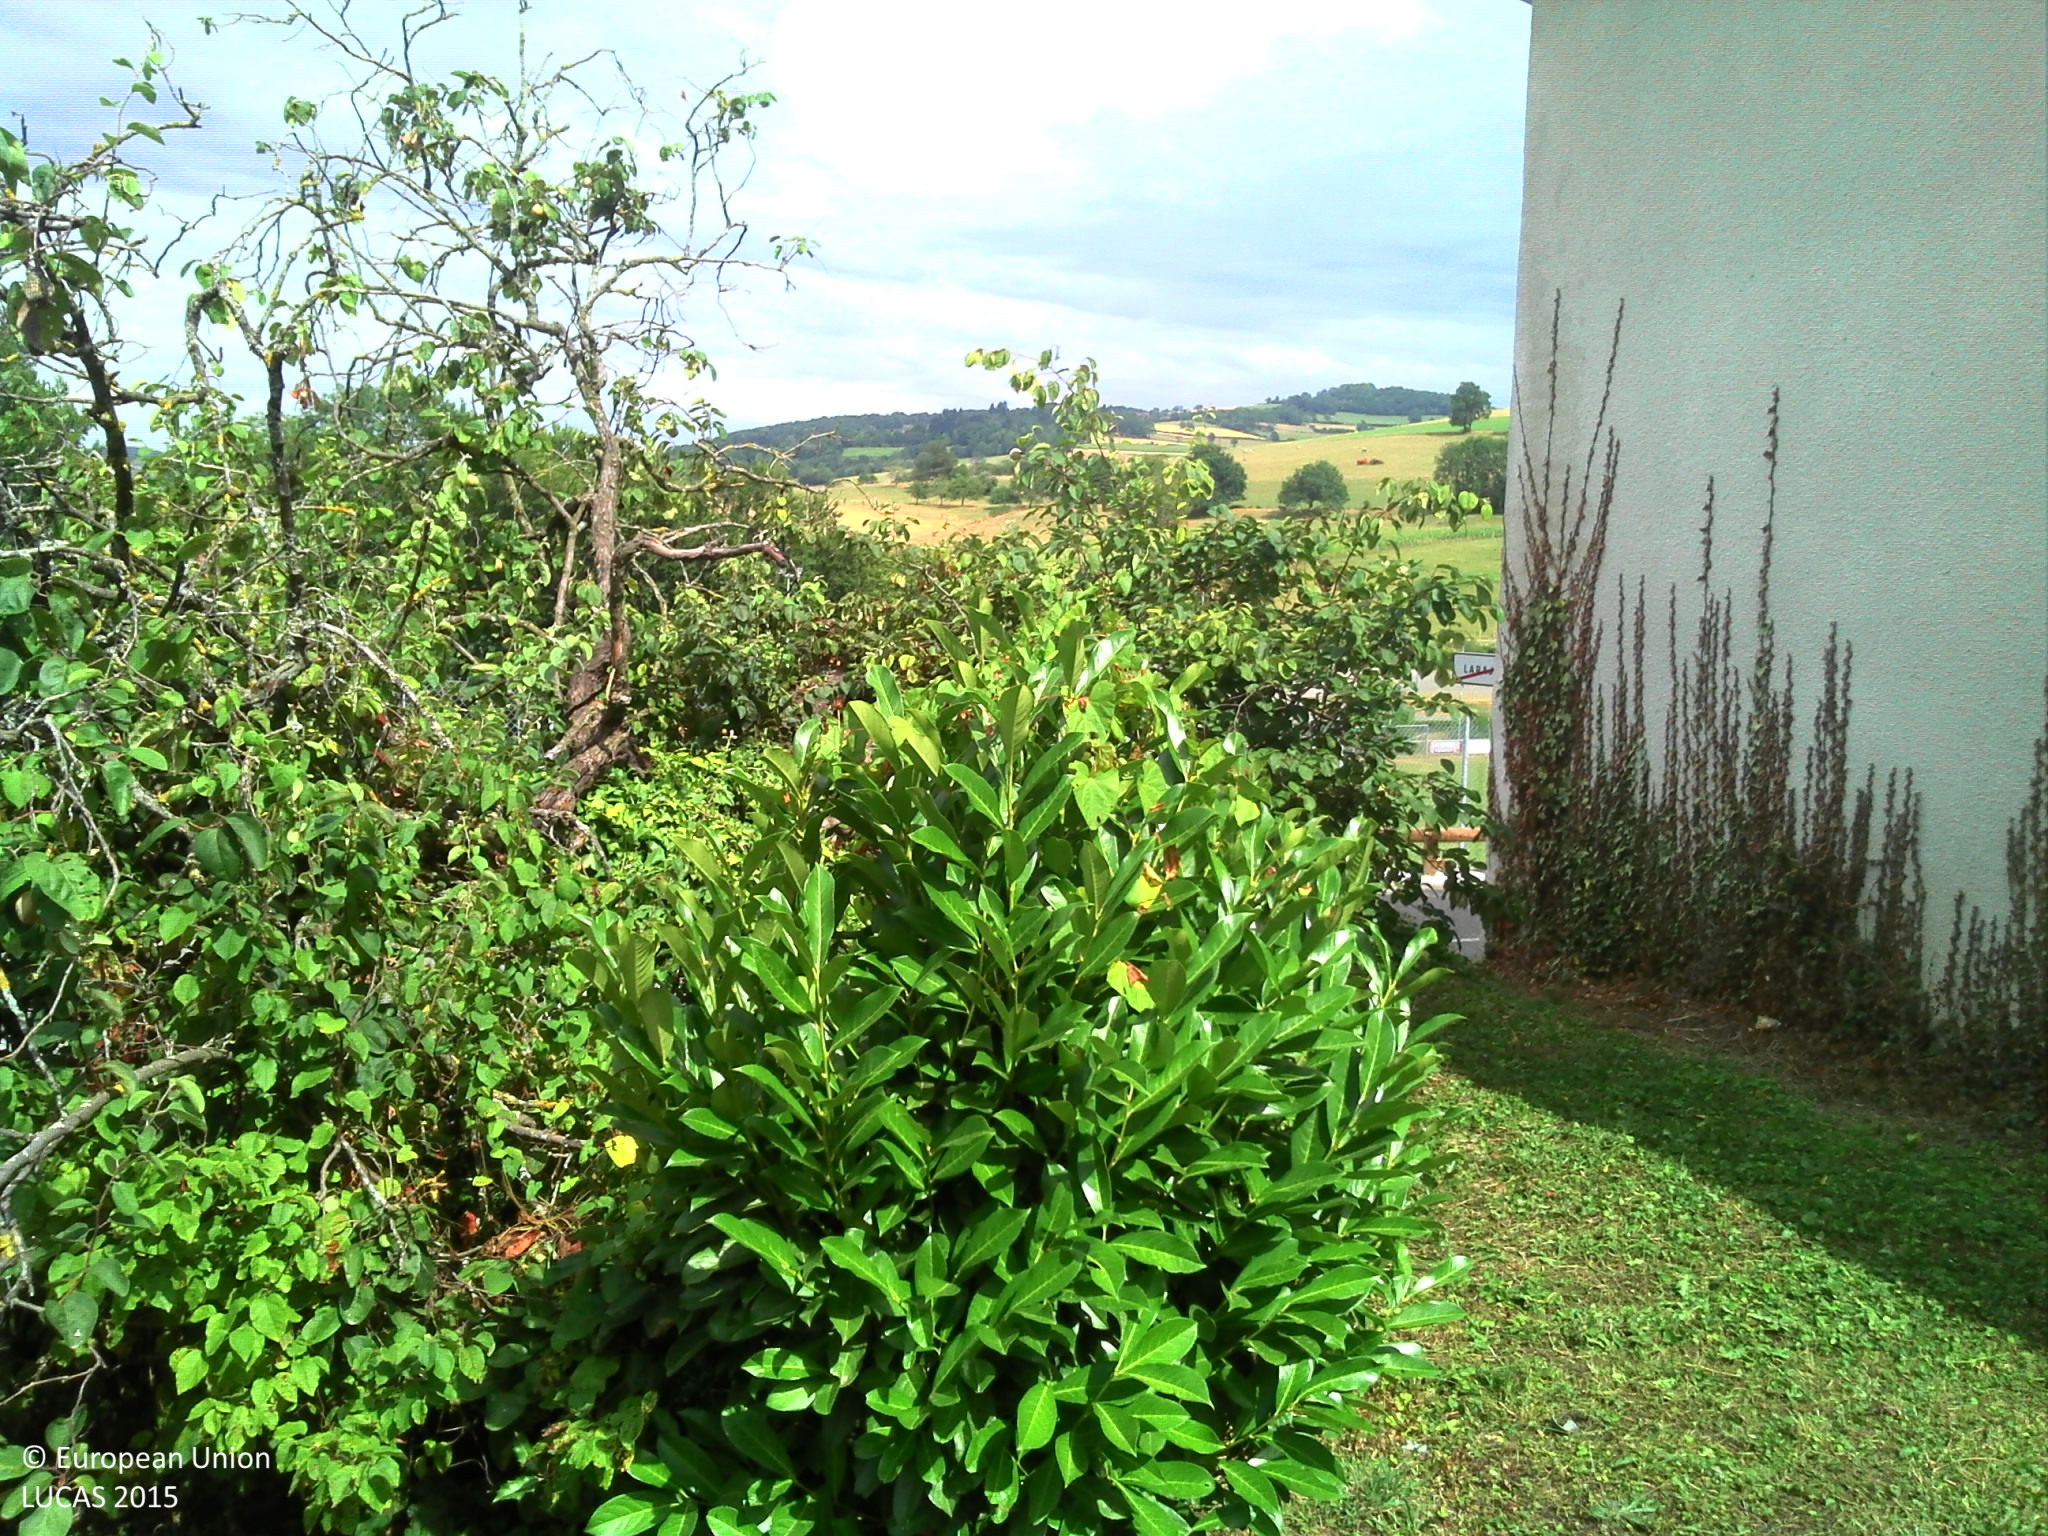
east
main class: Grassland
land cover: Grassland without tree/shrub cover
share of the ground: > 75 %
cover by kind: herbaceous plants 100 %
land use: Residential
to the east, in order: Grassland without tree/shrub cover; Artificial constructions in urban areas; Broadleaved woodland; Artificial constructions in urban areas
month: July
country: FR
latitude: 45.6140
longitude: 4.5022
